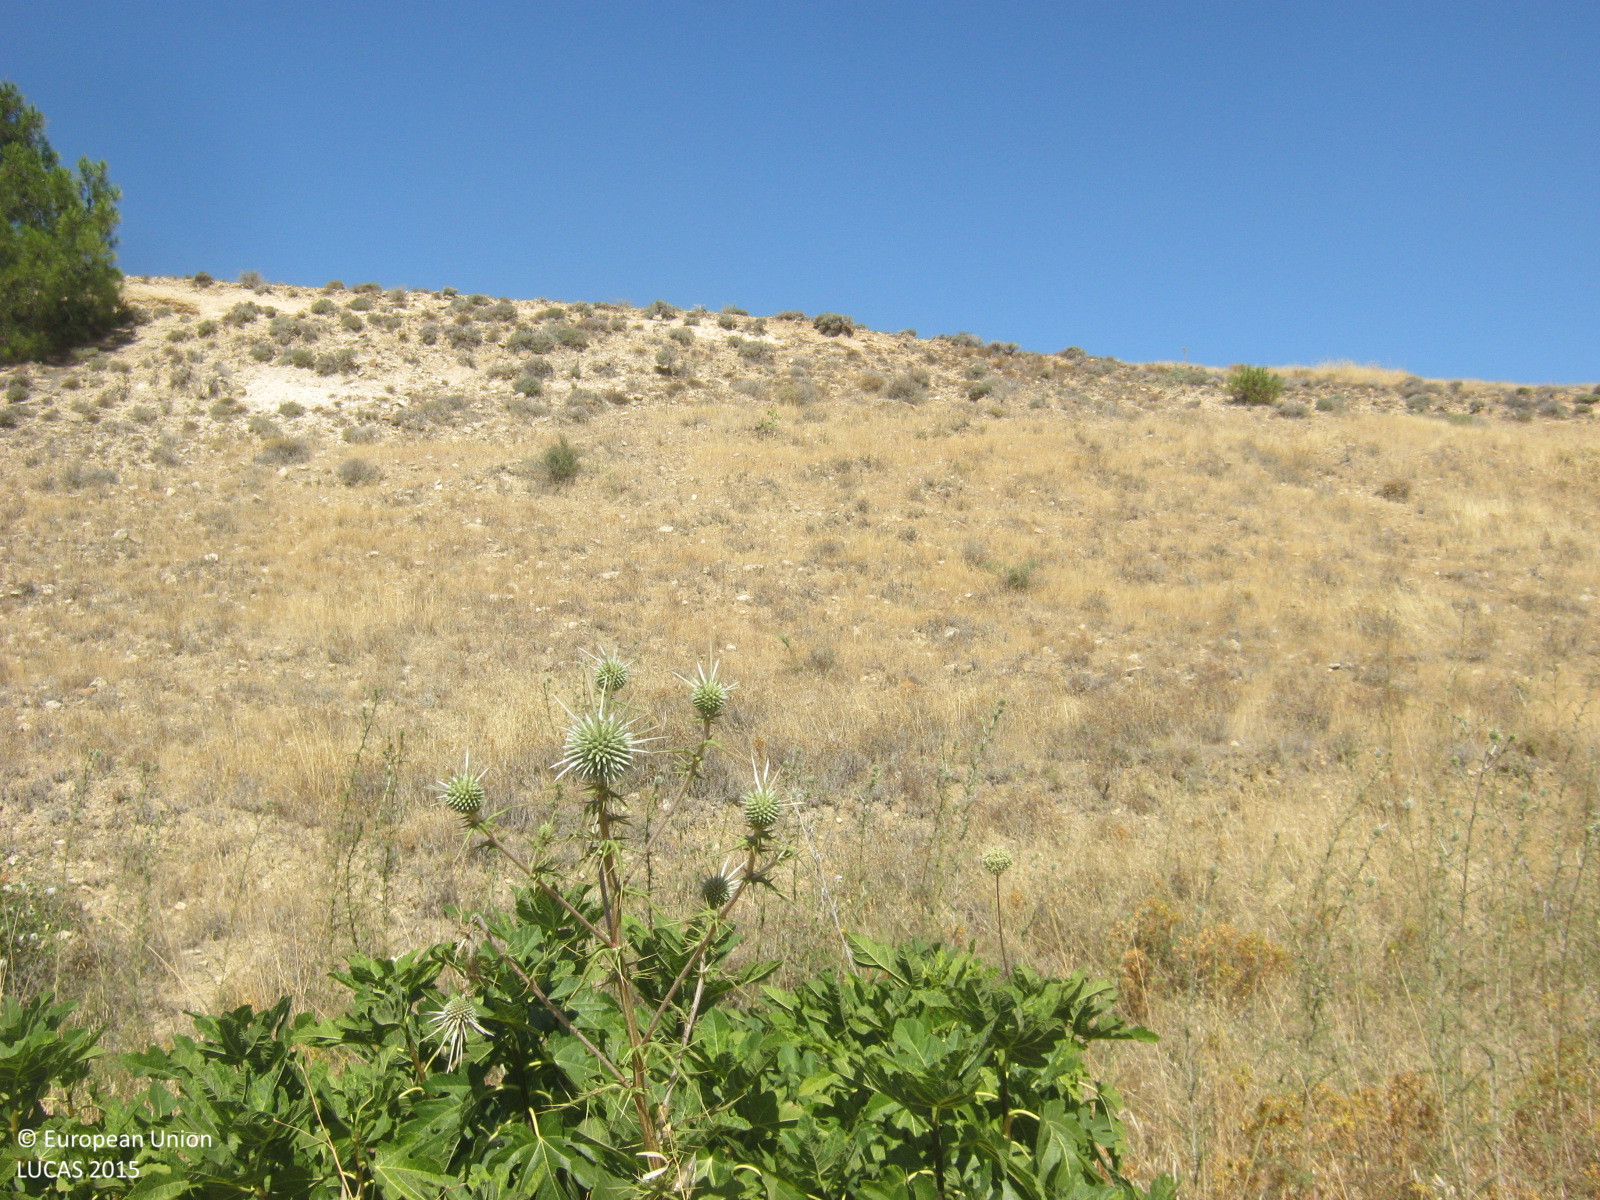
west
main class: Grassland
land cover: Spontaneously vegetated surfaces
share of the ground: > 75 %
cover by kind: herbaceous plants 85 %, unconsolidated bare surface 10 %, shrubs 5 %
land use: Semi-natural and natural areas not in use
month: June
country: CY
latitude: 35.0498
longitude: 33.1726
